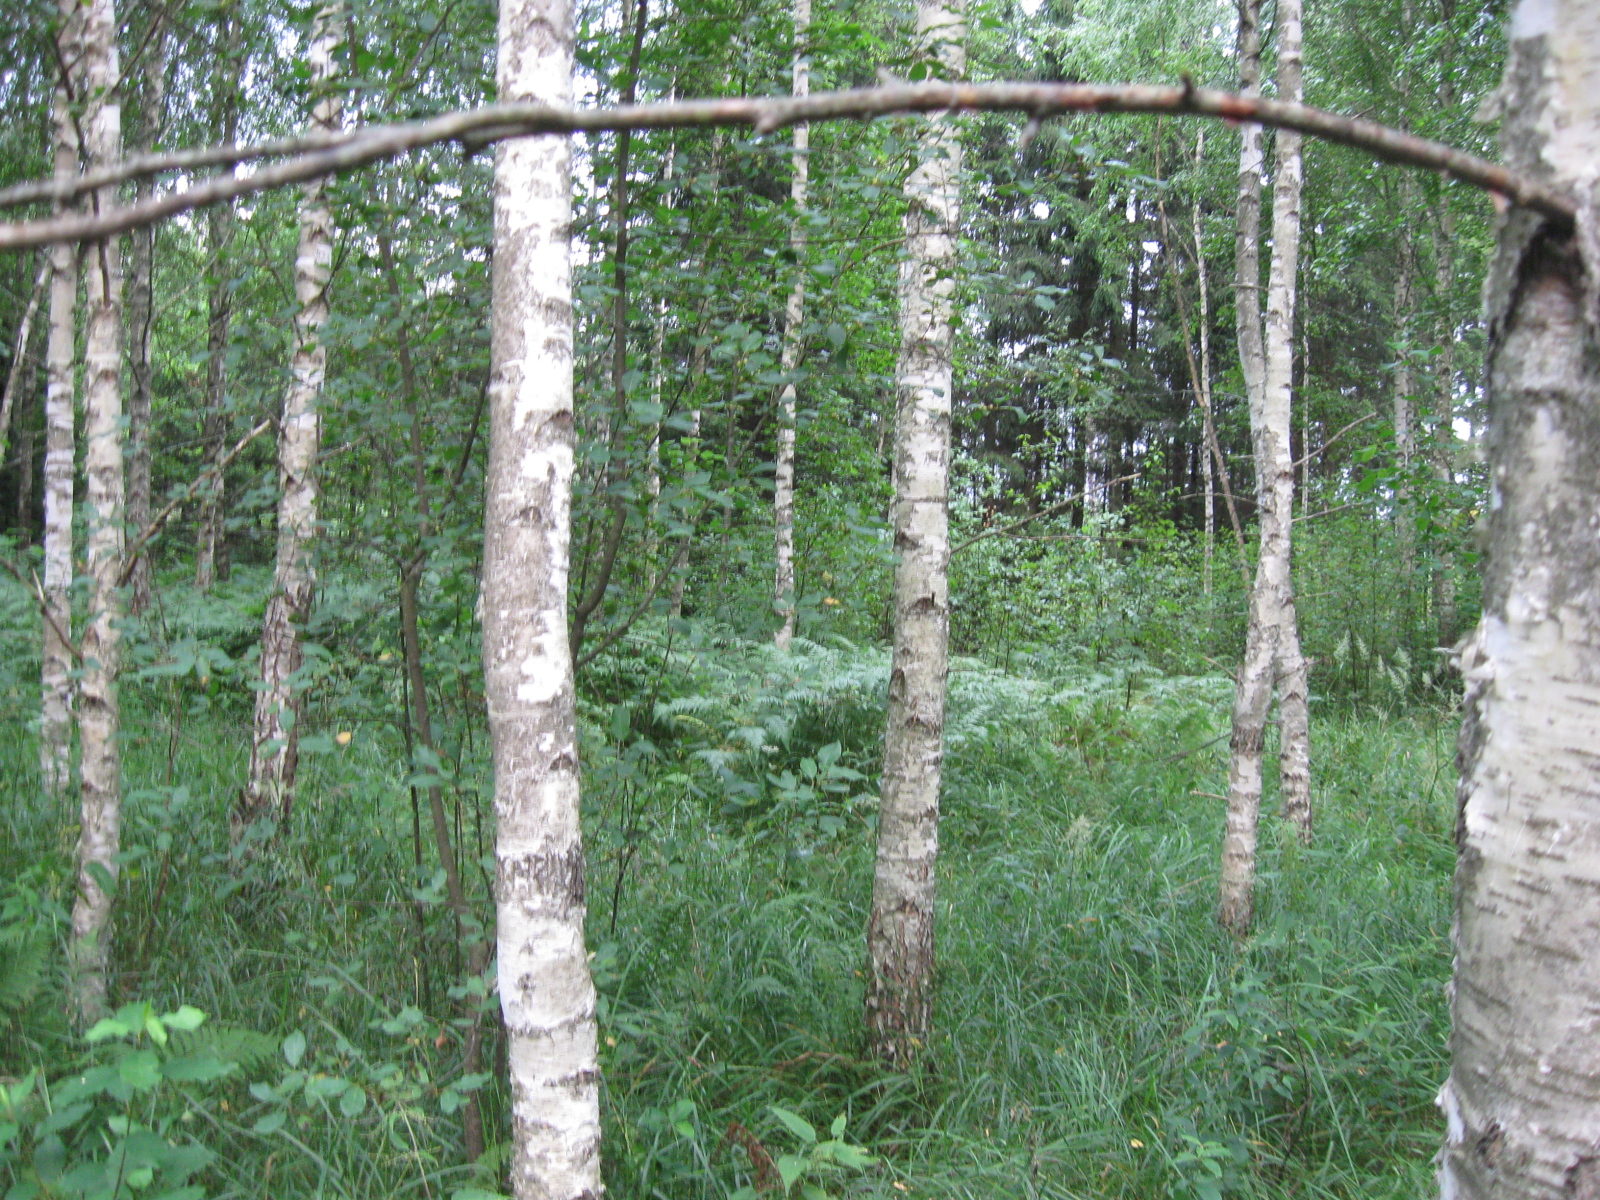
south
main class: Woodland
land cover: Broadleaved woodland
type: non-riverine alder, birch or aspen forest
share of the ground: > 75 %
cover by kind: broadleaved forest trees 70 %, herbaceous plants 20 %, coniferous forest trees 10 %
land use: Forestry
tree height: > 5 m
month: July
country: LT
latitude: 54.9315
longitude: 23.5820
